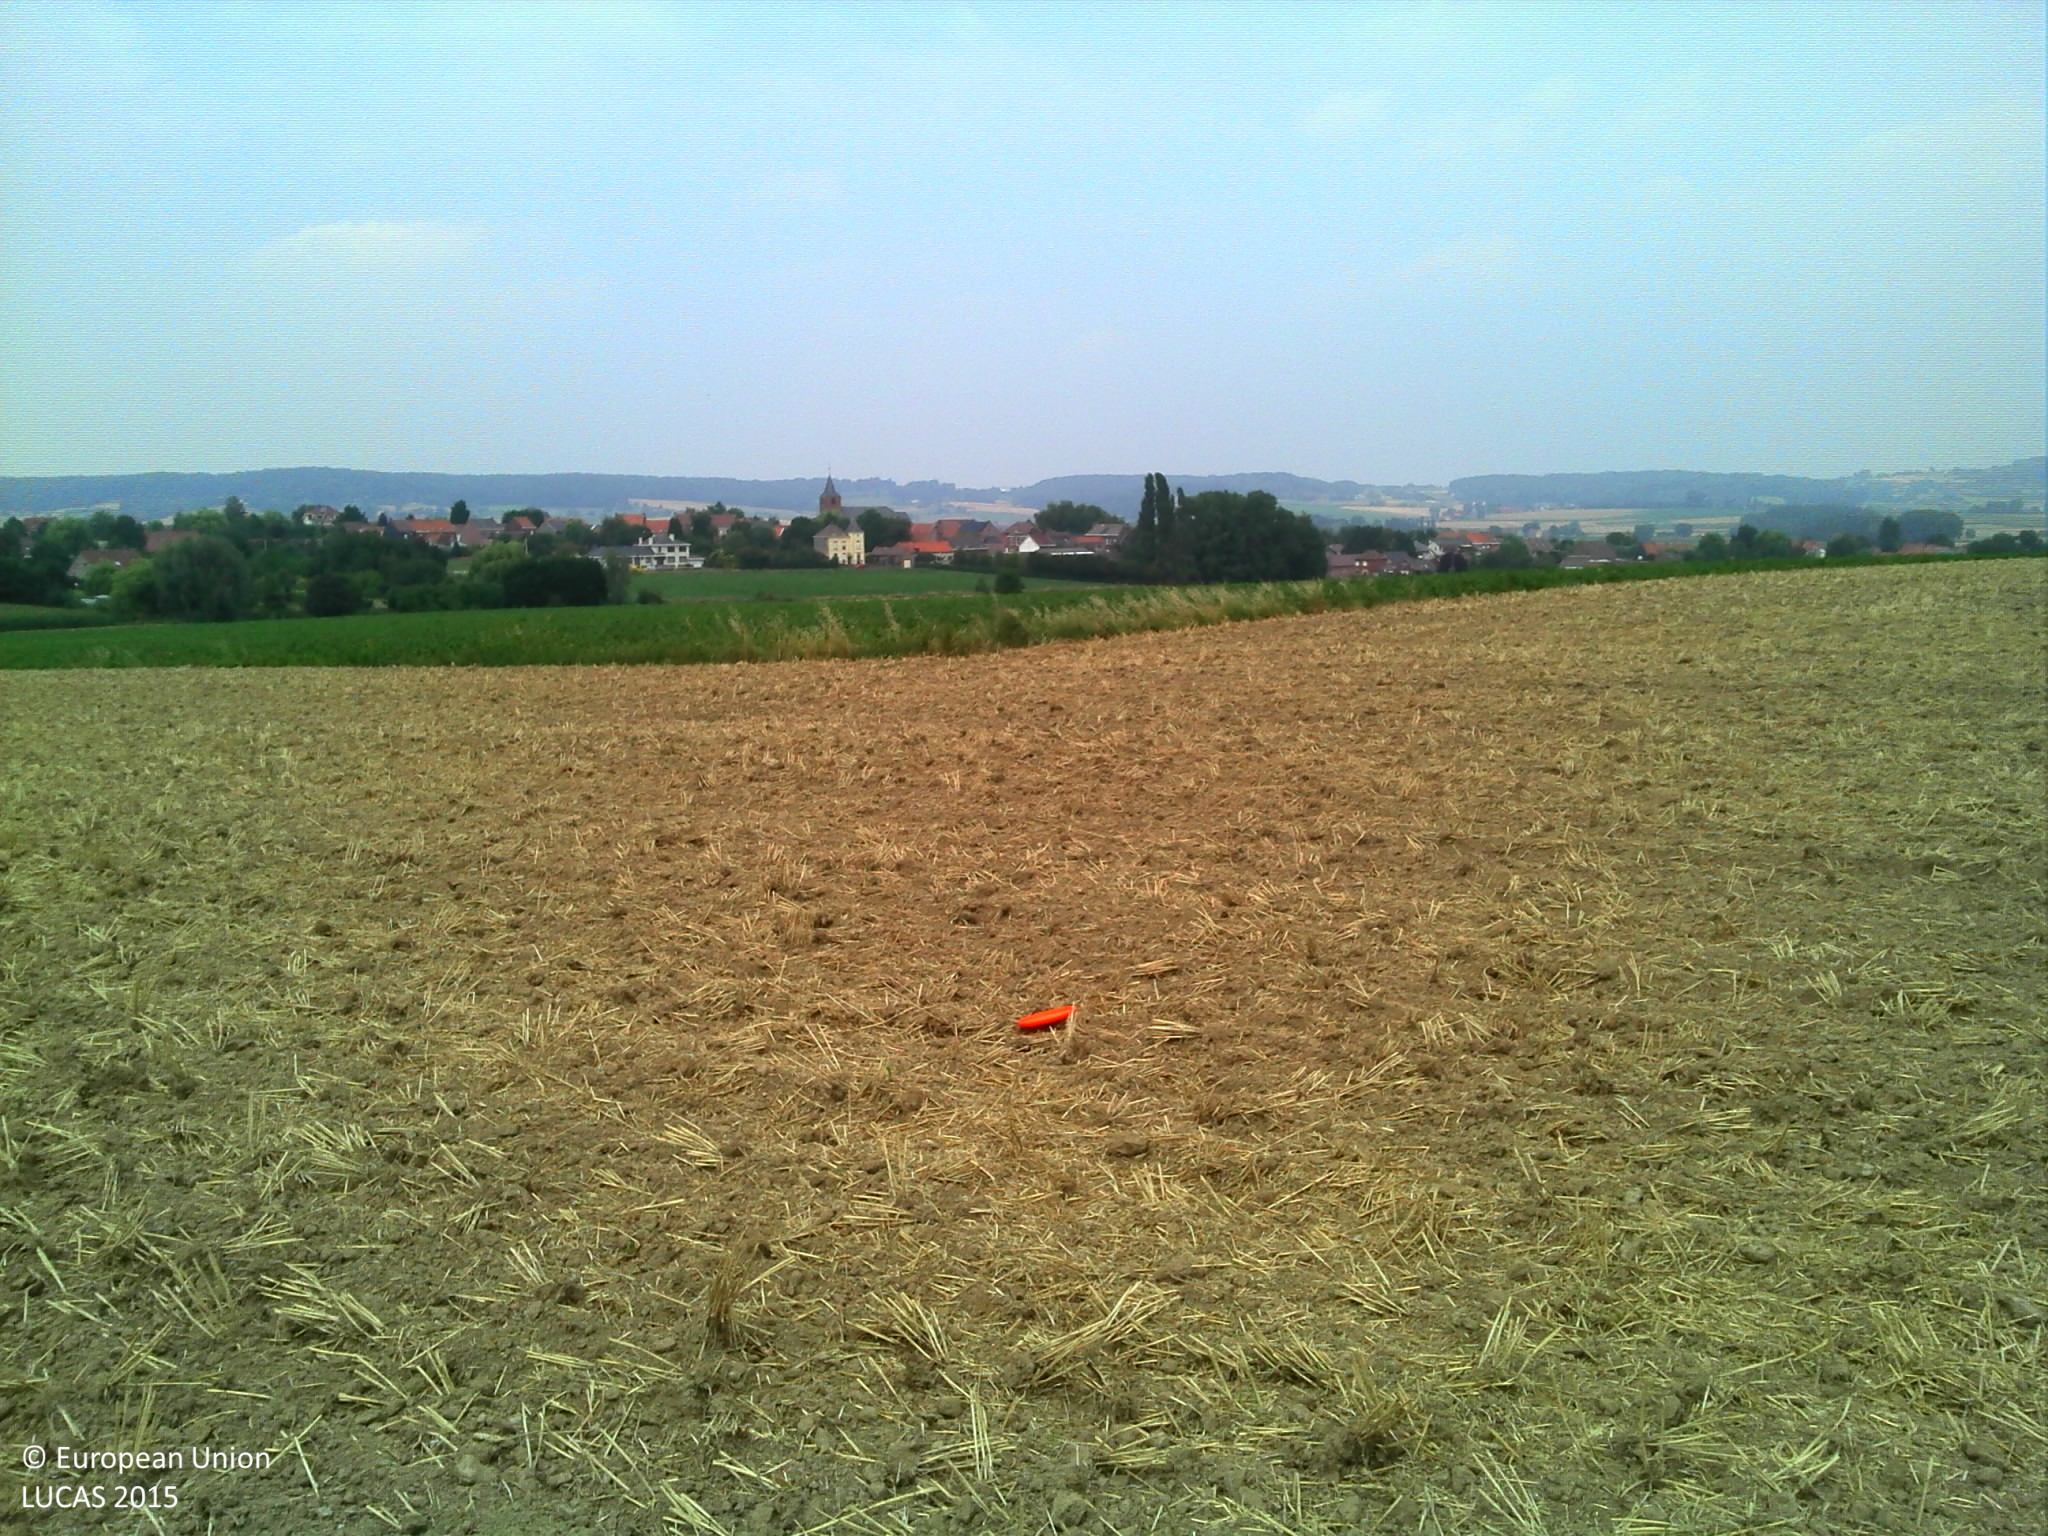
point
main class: Cropland
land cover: Common wheat
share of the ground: > 75 %
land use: Agriculture (excluding fallow land and kitchen gardens)
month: August
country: BE
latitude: 50.7214
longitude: 3.5190
